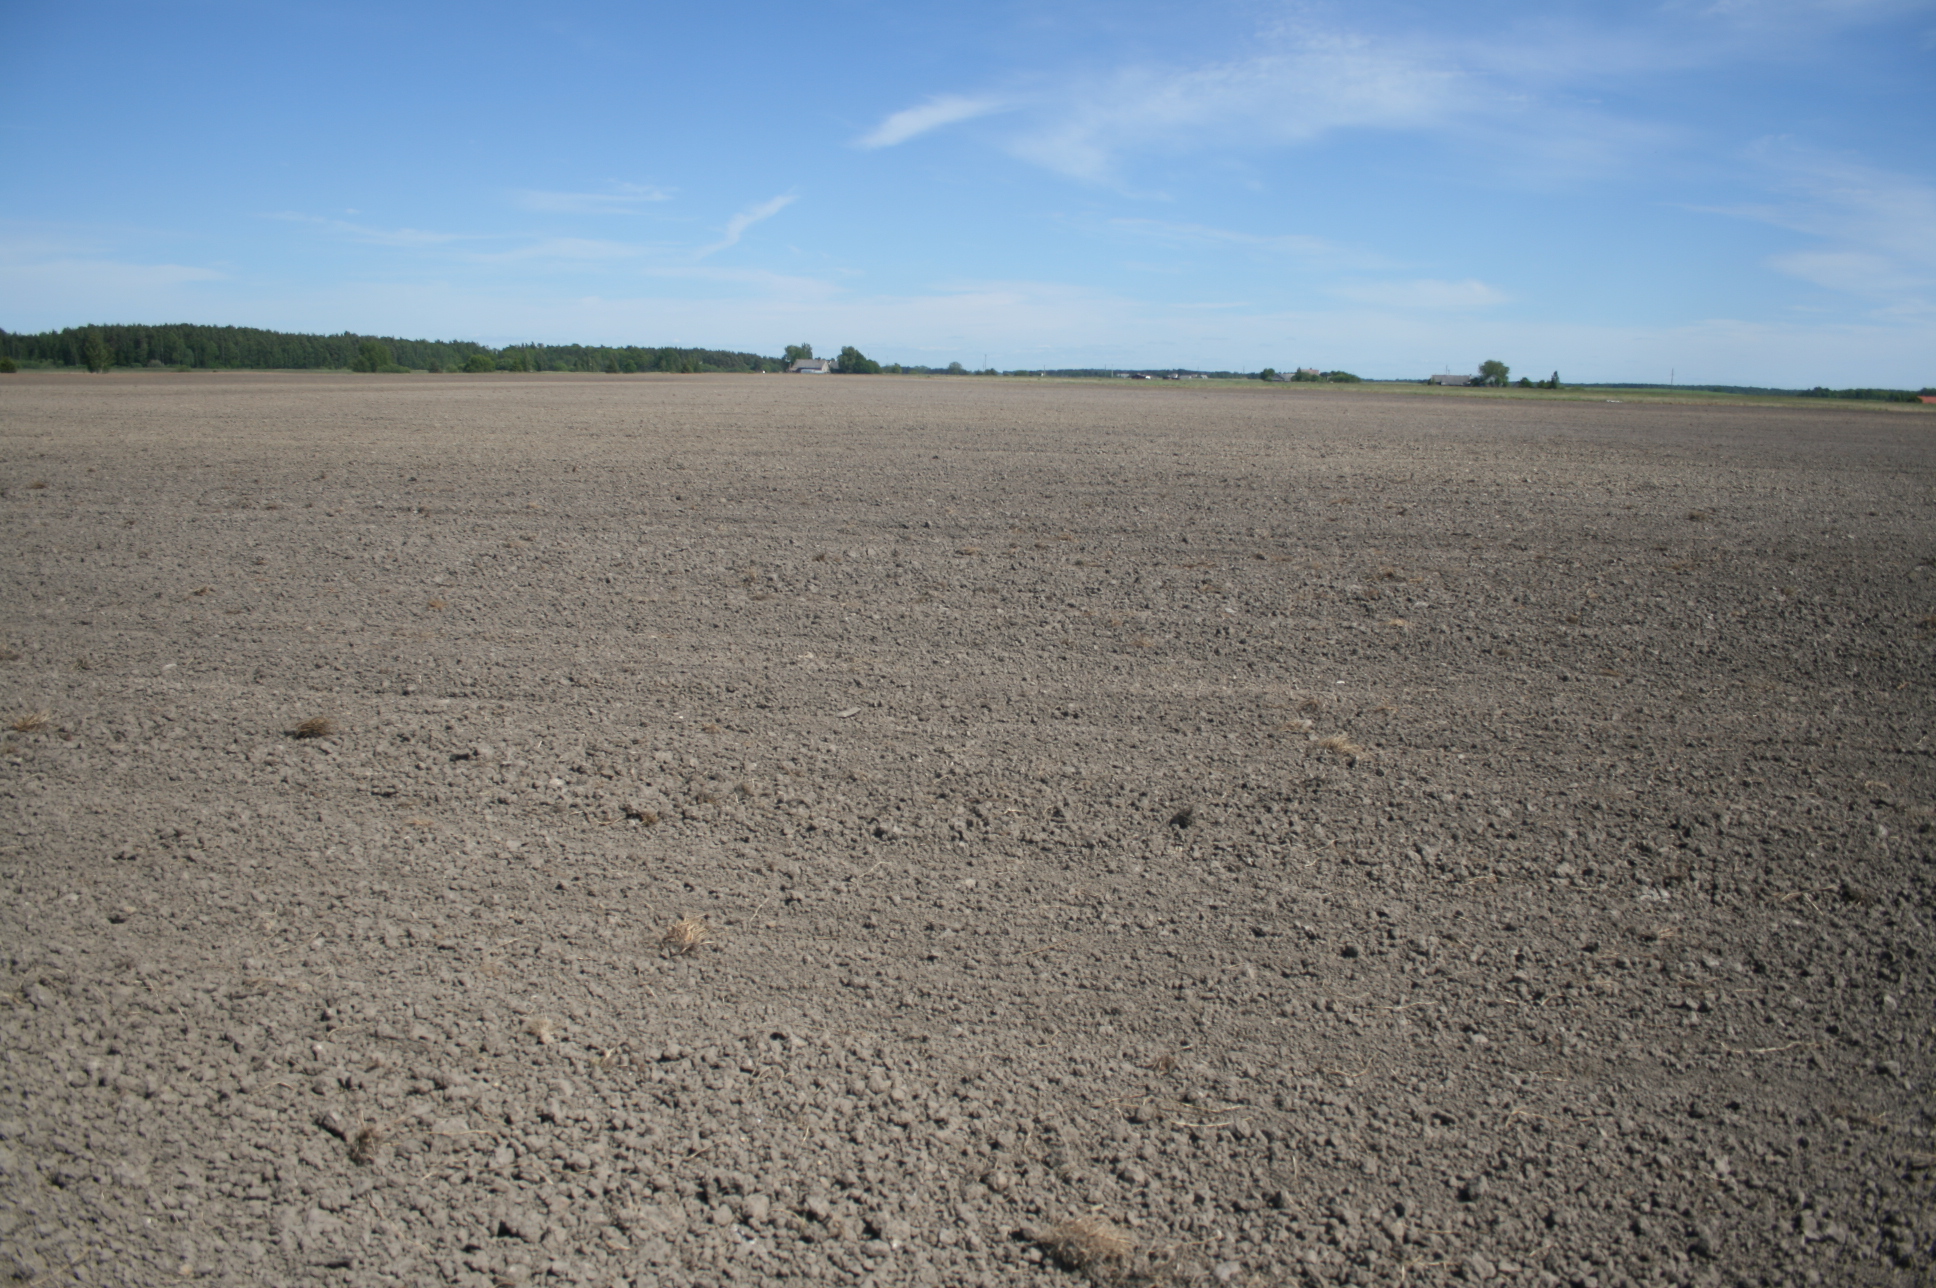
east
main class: Cropland
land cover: Rye
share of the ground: < 10 %
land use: Agriculture (excluding fallow land and kitchen gardens)
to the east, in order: Rye
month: June
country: LT
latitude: 55.9302
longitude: 21.4235
